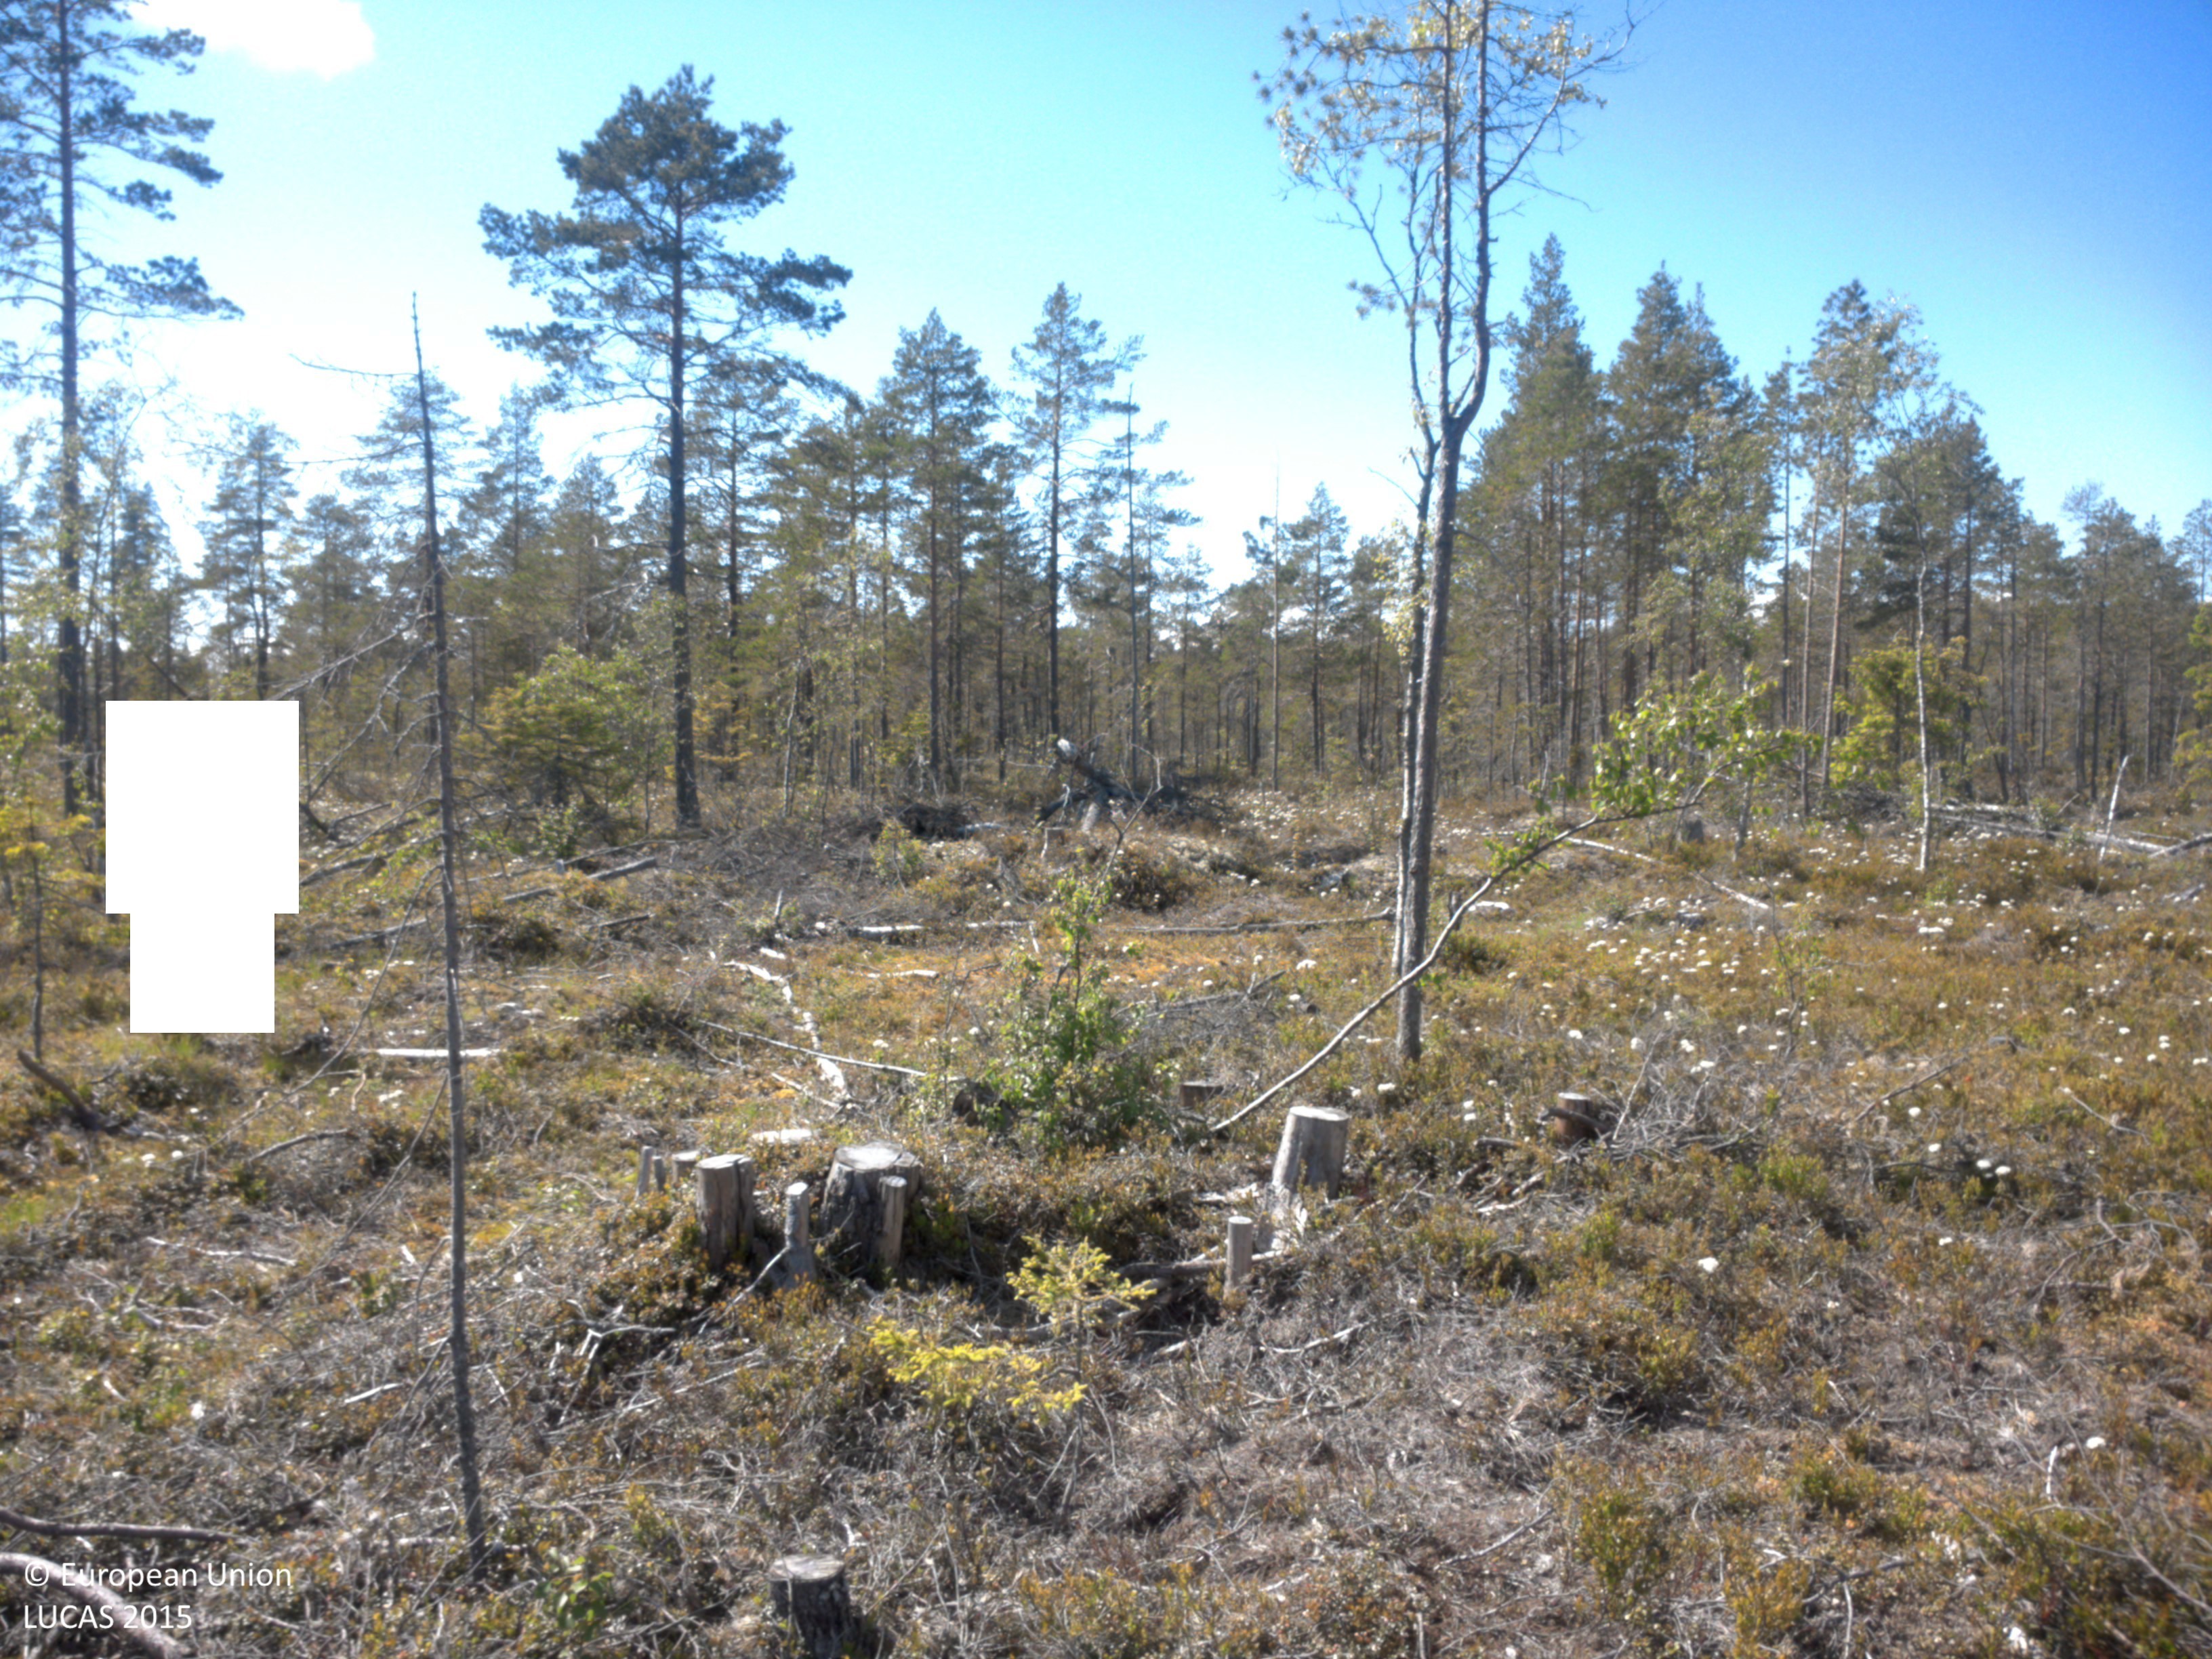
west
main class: Shrubland
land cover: Shrubland with sparse tree cover
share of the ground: > 75 %
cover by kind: shrubs 85 %, unconsolidated bare surface 10 %, coniferous forest trees 5 %
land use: Forestry
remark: Clear cut
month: June
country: SE
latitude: 63.4983
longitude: 19.7233
